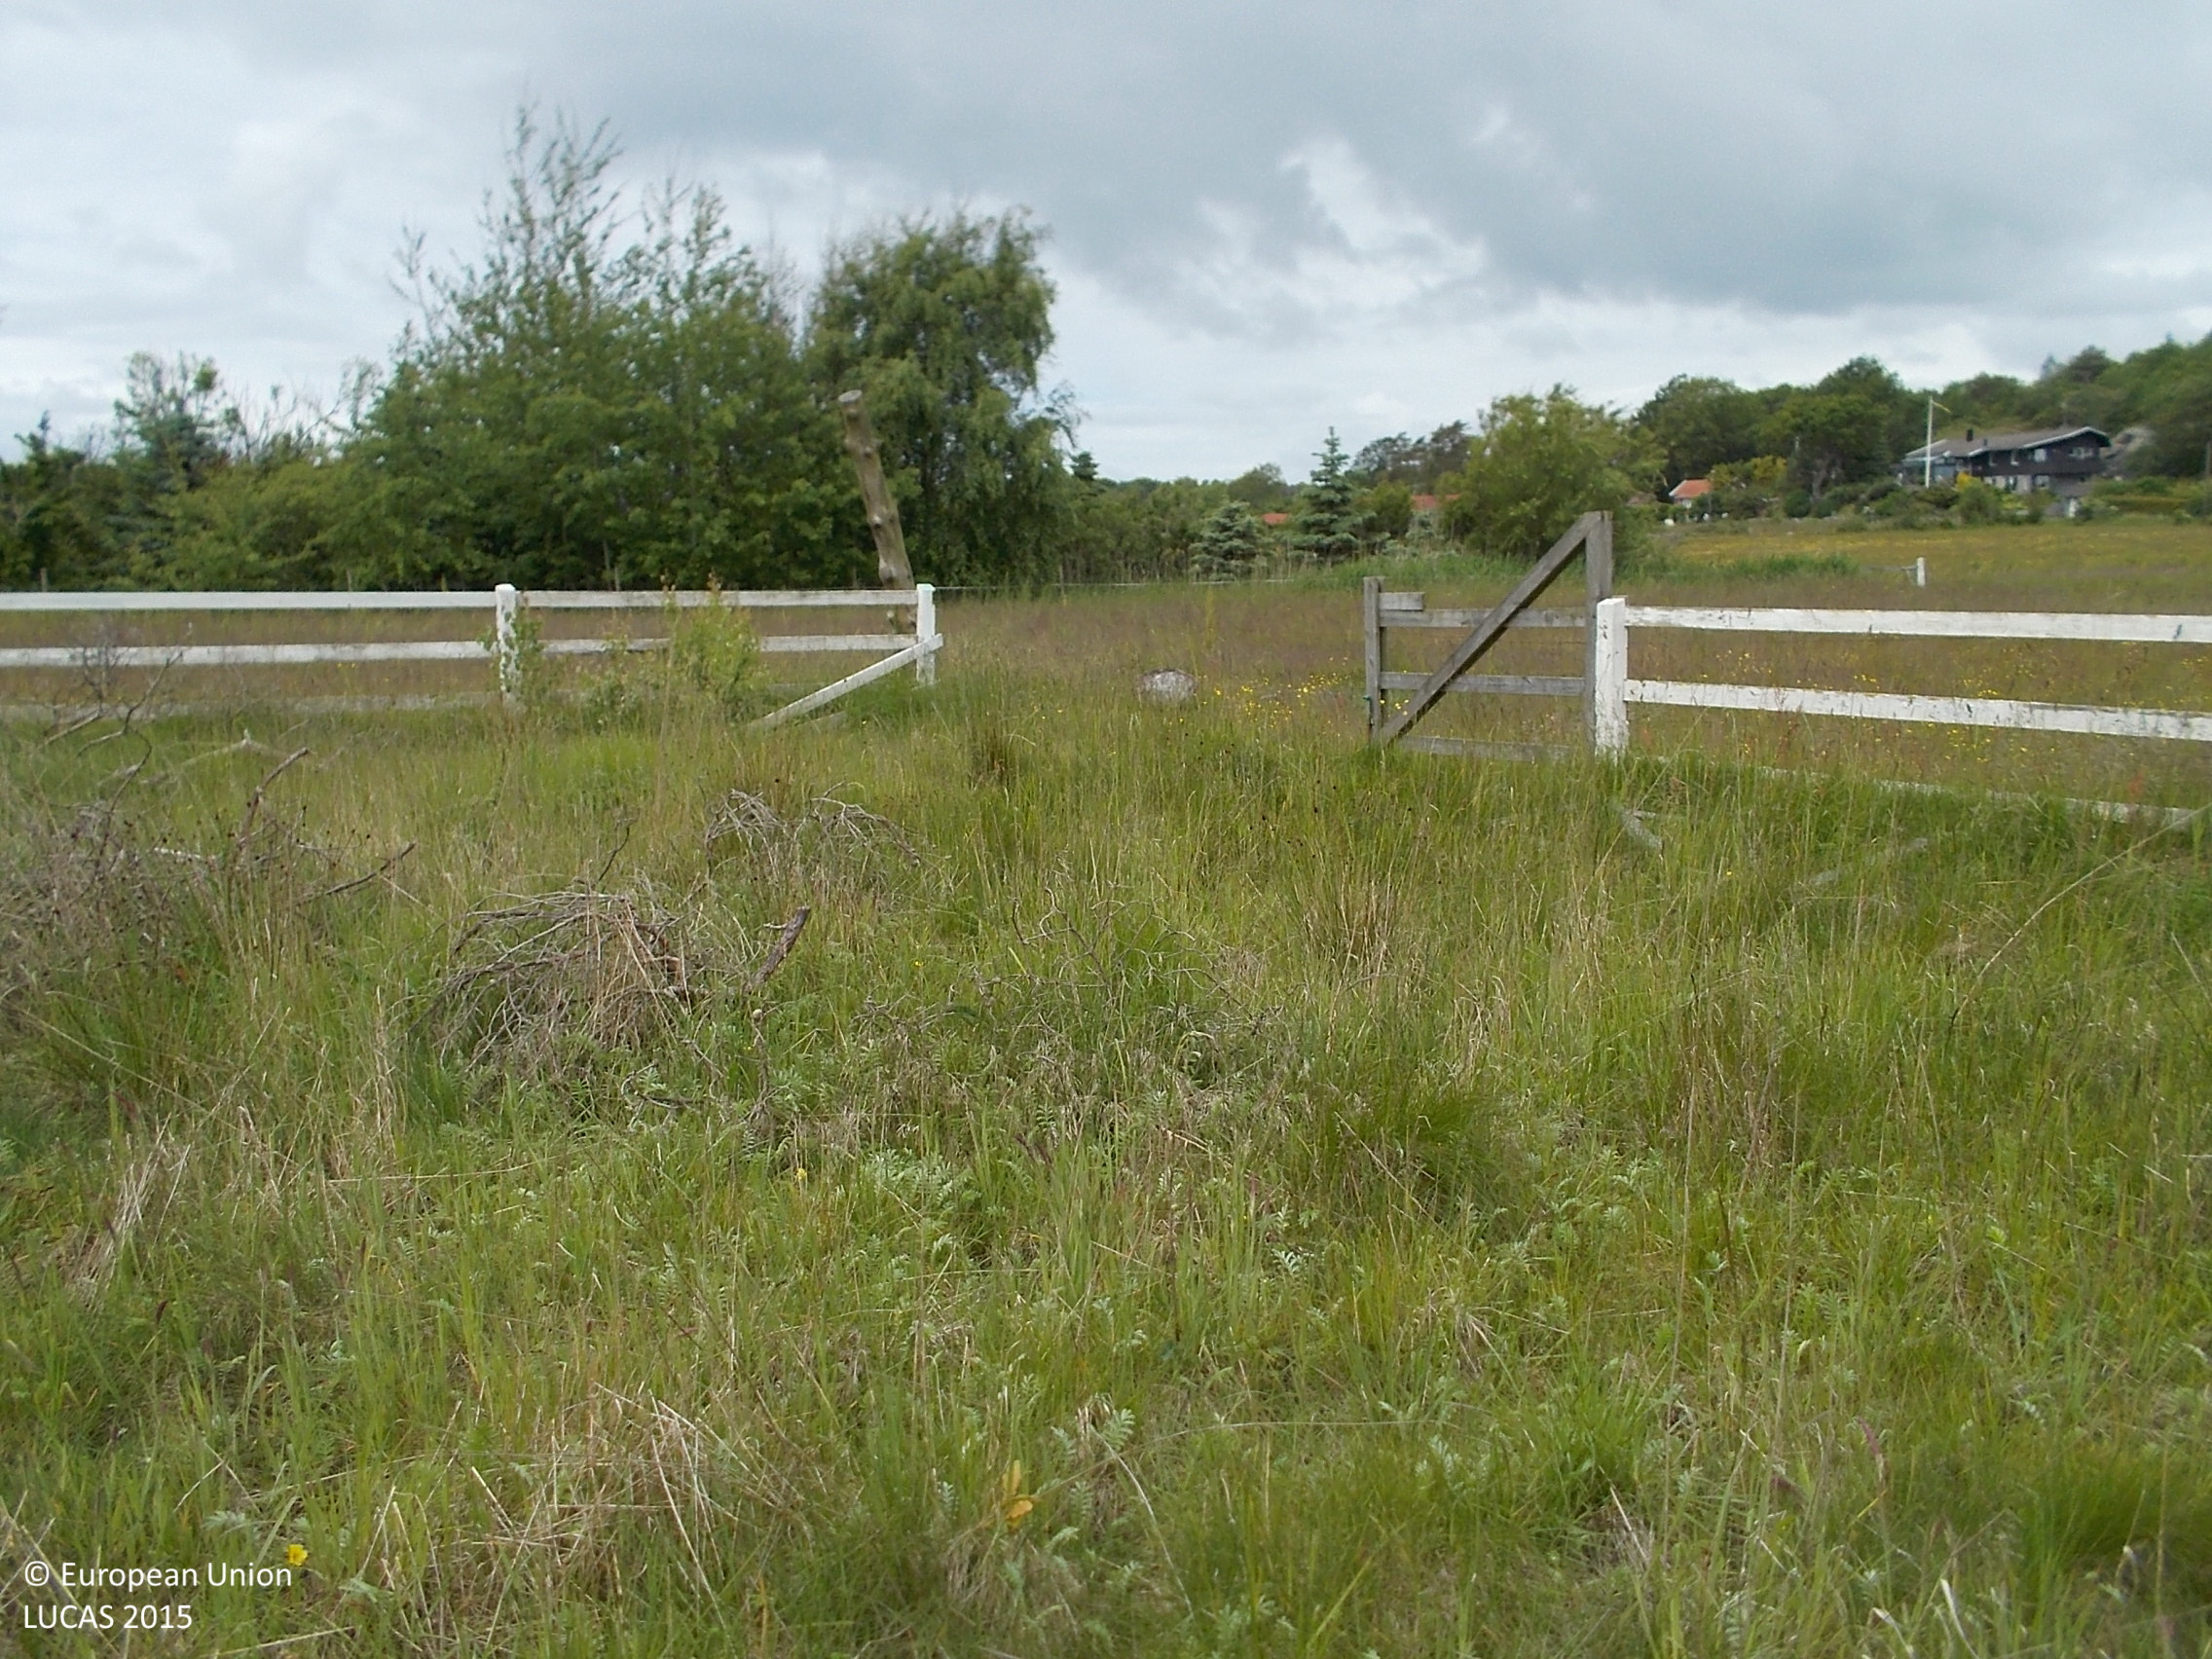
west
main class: Grassland
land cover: Grassland with sparse tree/shrub cover
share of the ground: > 75 %
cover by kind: herbaceous plants 90 %, broadleaved forest trees 5 %, shrubs 5 %
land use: Abandoned areas
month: June
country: SE
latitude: 57.3959
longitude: 11.9439
